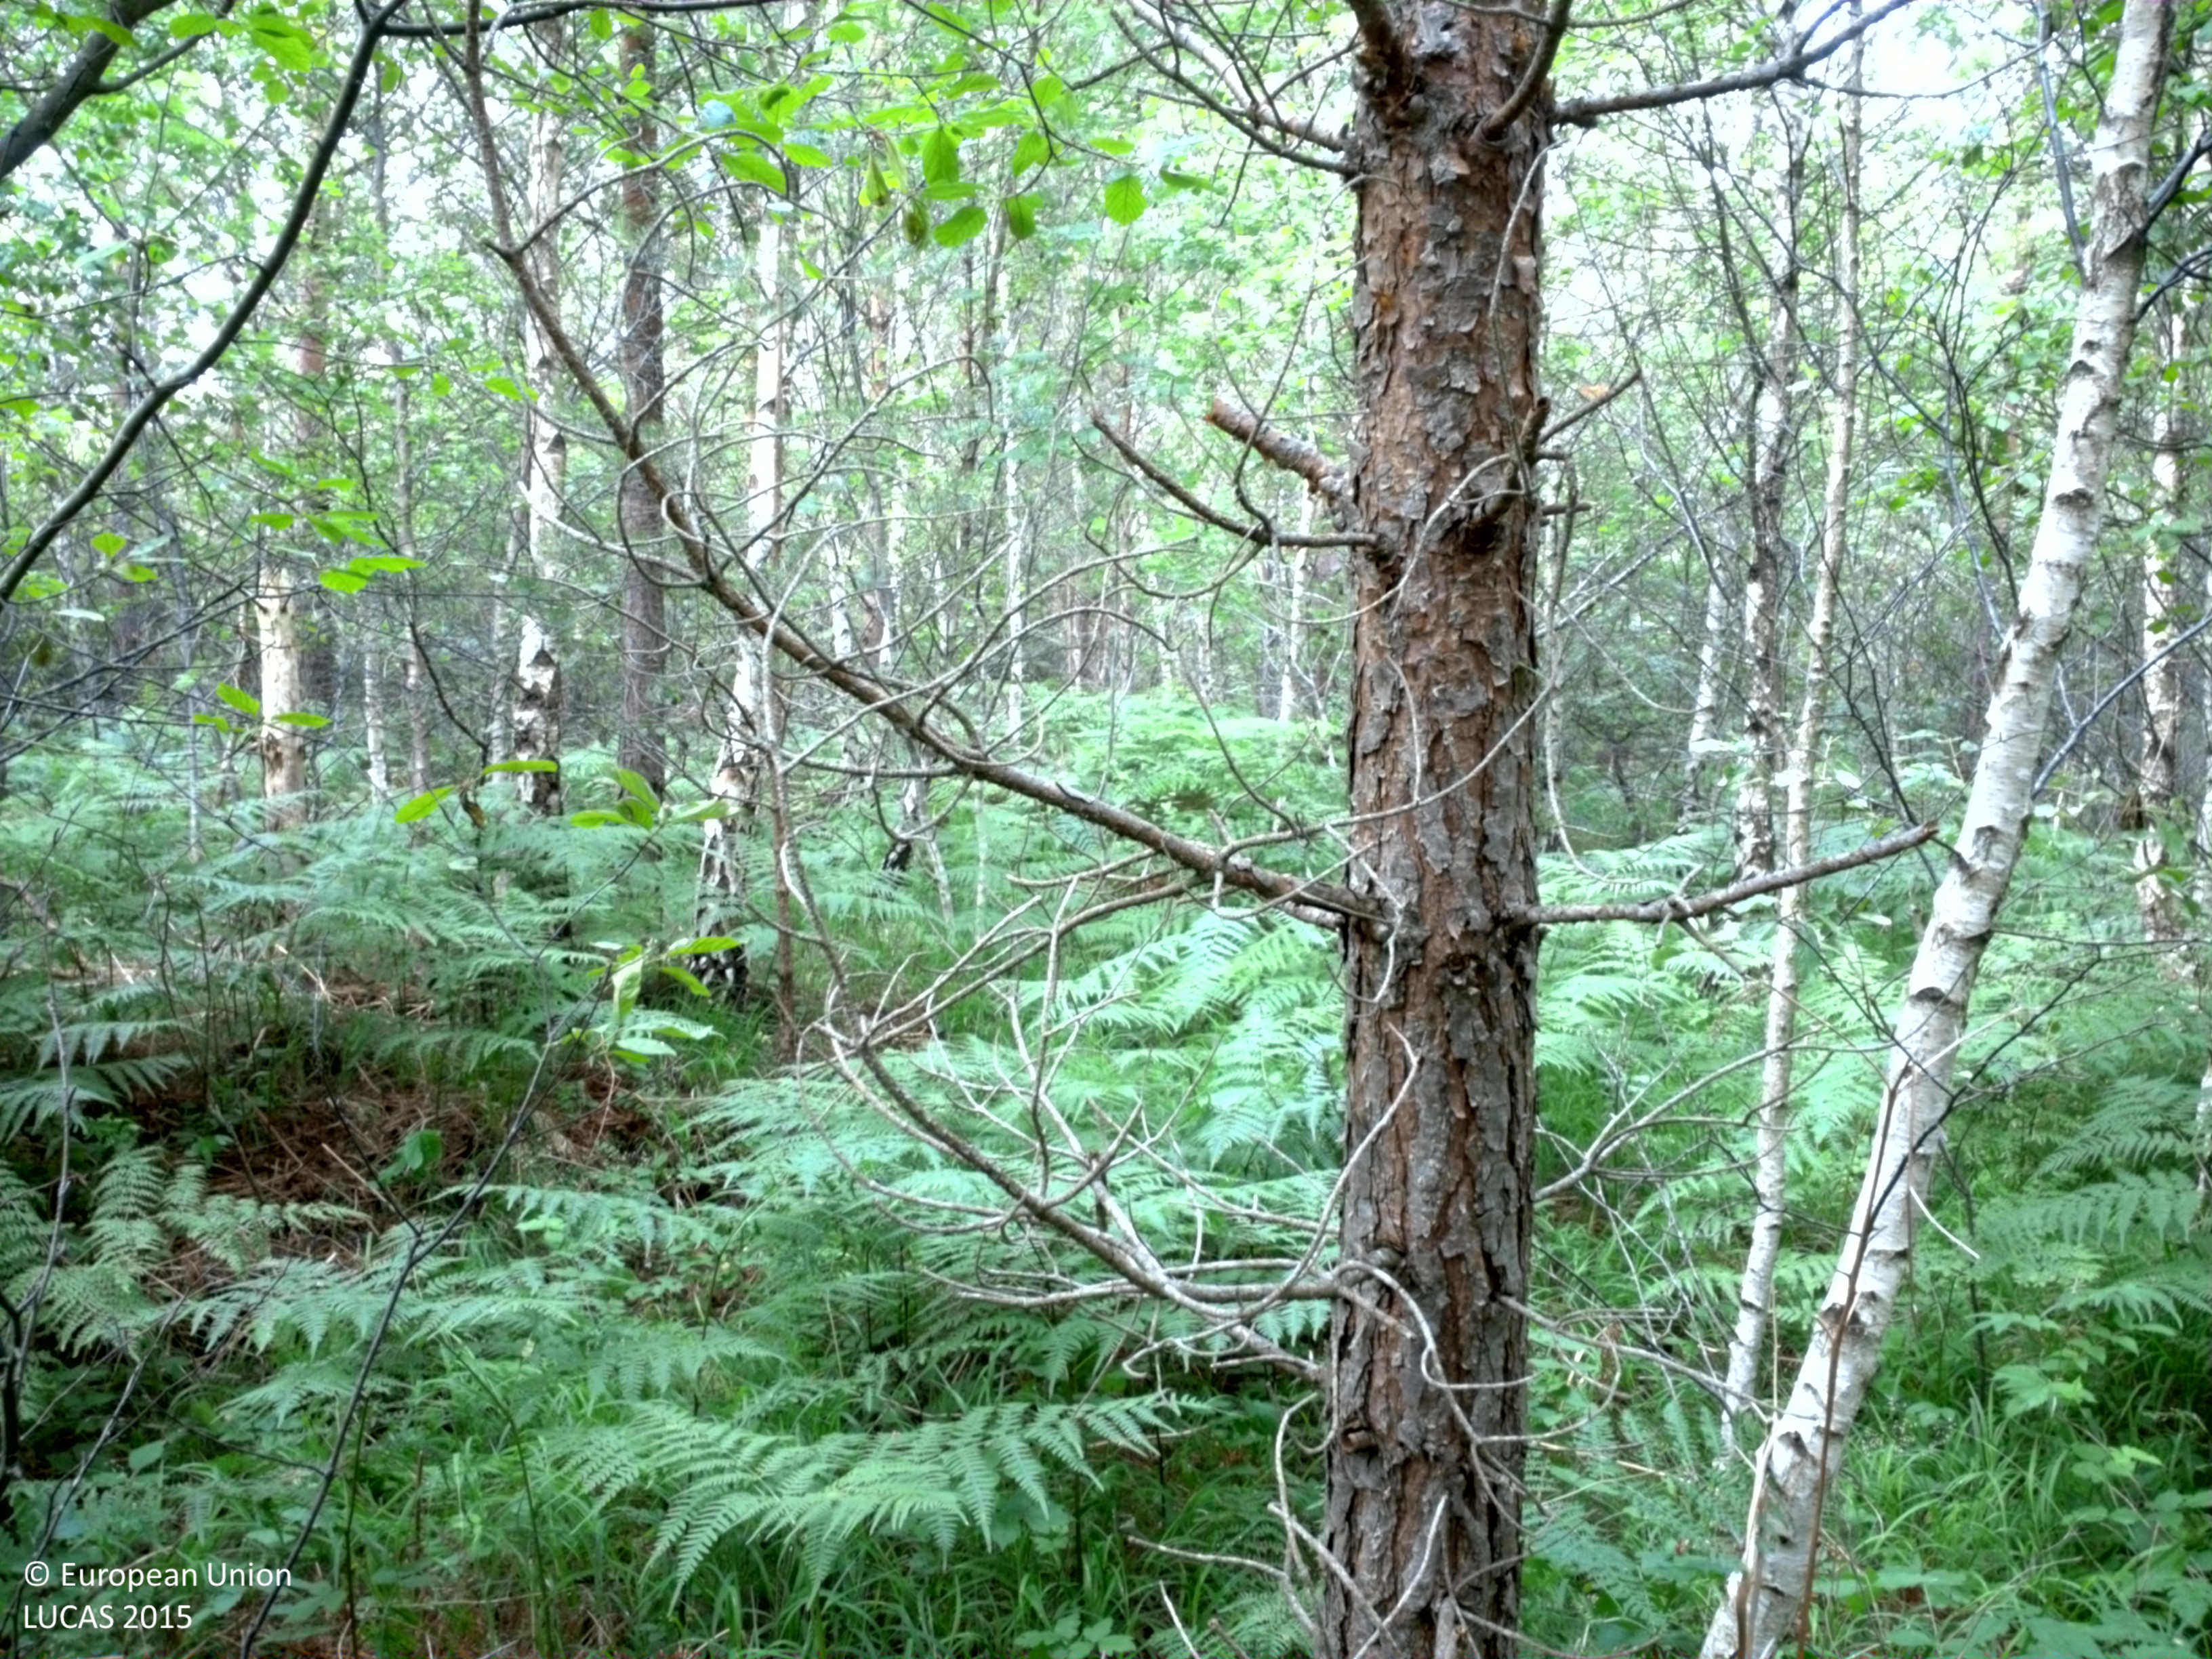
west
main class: Woodland
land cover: Pine dominated mixed woodland
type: hemiboreal forest and nemoral coniferous forest and mixed broadleaved-coniferous forest
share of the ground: > 75 %
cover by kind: coniferous forest trees 55 %, broadleaved forest trees 25 %, herbaceous plants 15 %, shrubs 5 %
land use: Forestry
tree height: > 5 m
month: July
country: SE
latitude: 57.2864
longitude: 18.1197
